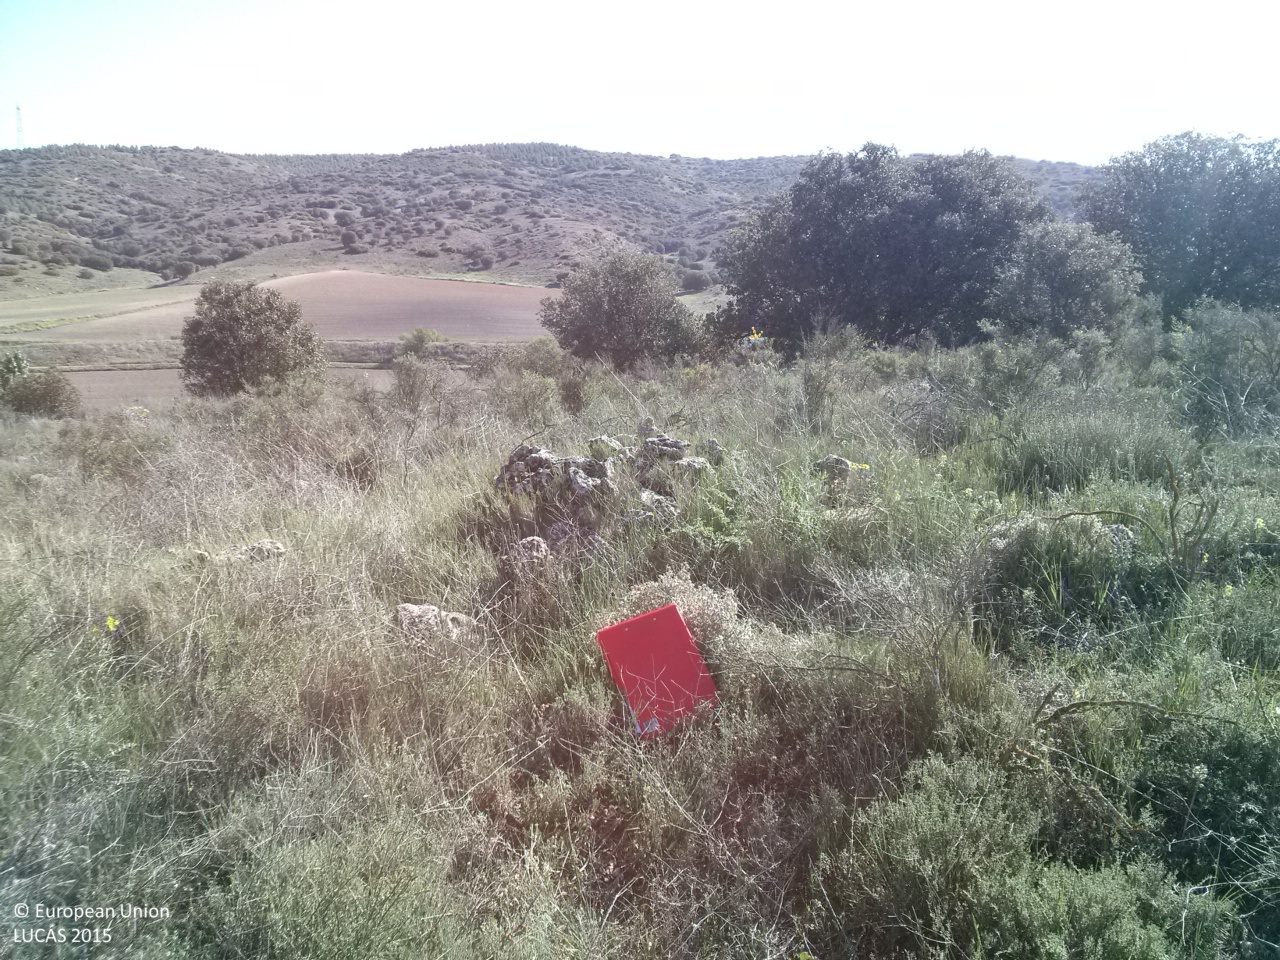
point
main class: Woodland
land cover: Broadleaved woodland
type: broadleaved evergreen forest
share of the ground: 10 - 25 %
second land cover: Shrubland without tree cover
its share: 50 - 75 %
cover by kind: shrubs 60 %, herbaceous plants 25 %, broadleaved forest trees 15 %
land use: Forestry
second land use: Agriculture (excluding fallow land and kitchen gardens)
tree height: < 5 m
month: May
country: ES
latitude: 39.8824
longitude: -2.8007
